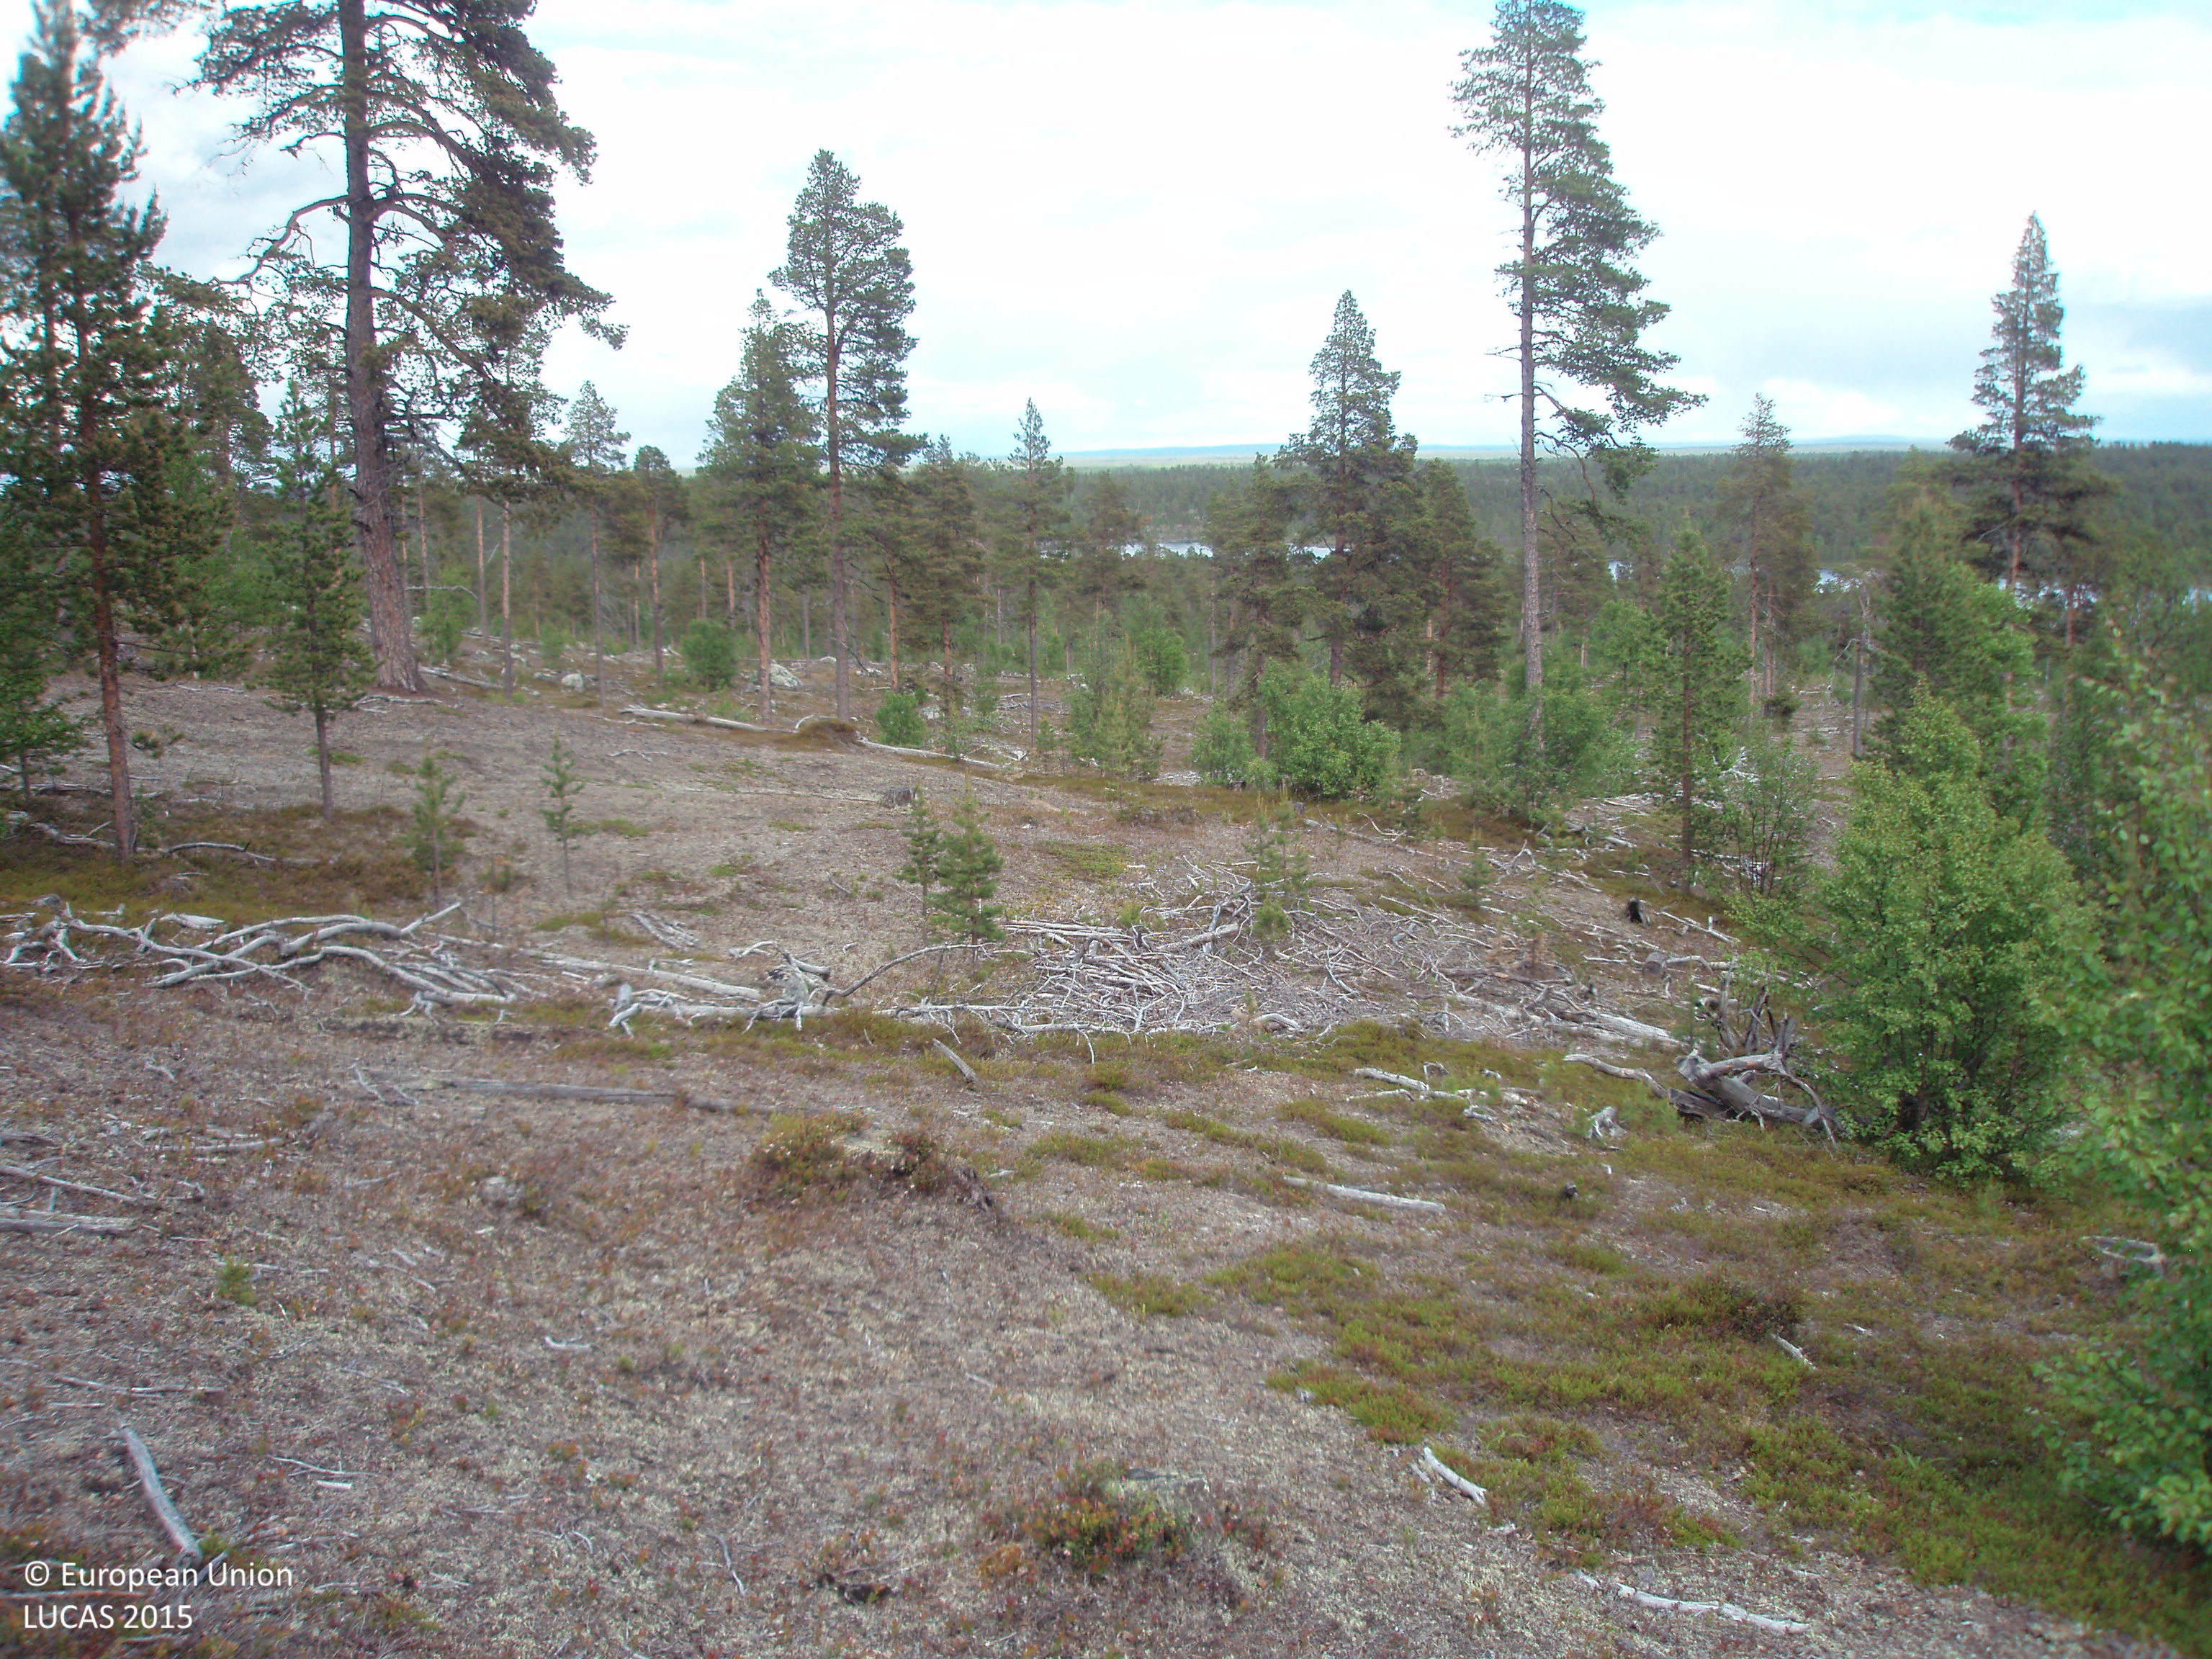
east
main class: Woodland
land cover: Pine dominated mixed woodland
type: boreal forest
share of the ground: 10 - 25 %
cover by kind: lichens and mosses 60 %, shrubs 25 %, coniferous forest trees 10 %, broadleaved forest trees 5 %
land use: Forestry
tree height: > 5 m
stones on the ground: < 10 %
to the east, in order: Pine dominated mixed woodland; Shrubland with sparse tree cover
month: July
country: FI
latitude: 69.2223
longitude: 27.8848
